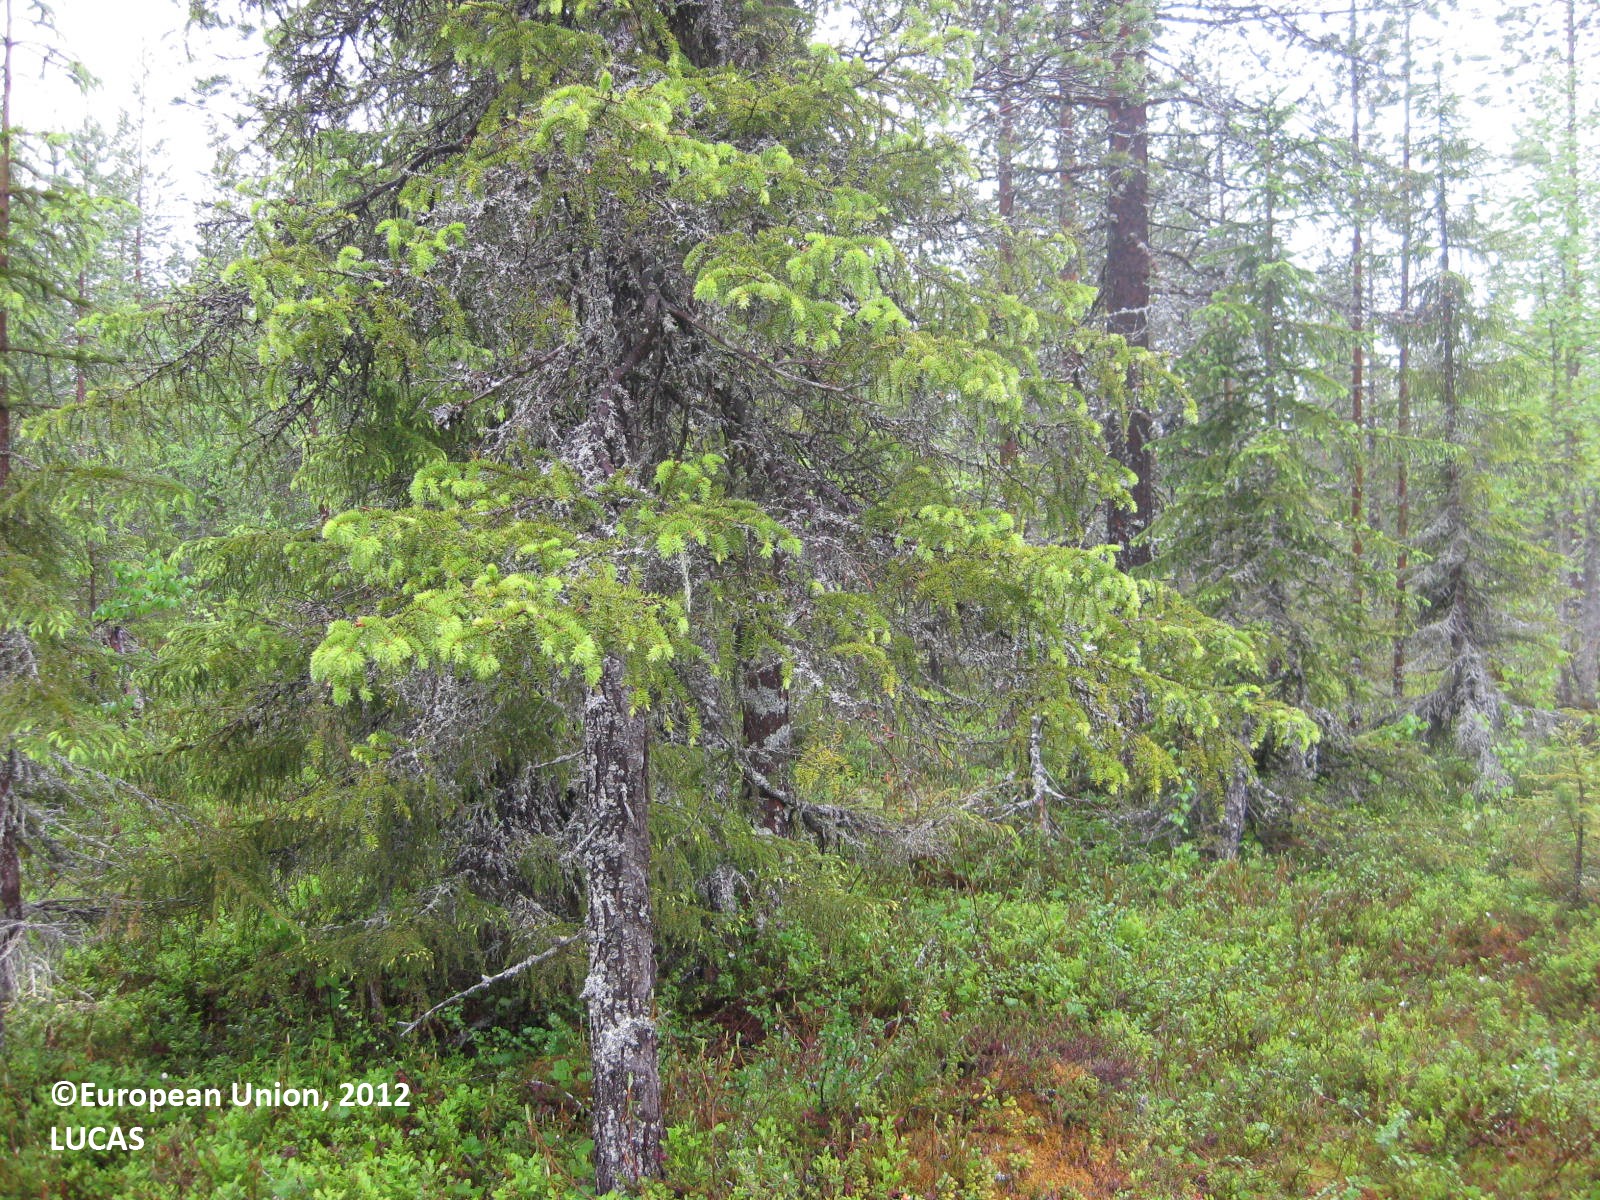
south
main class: Woodland
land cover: Other mixed woodland
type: boreal forest
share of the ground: 50 - 75 %
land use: Forestry
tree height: > 5 m
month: June
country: FI
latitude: 65.3449
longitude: 29.0240
